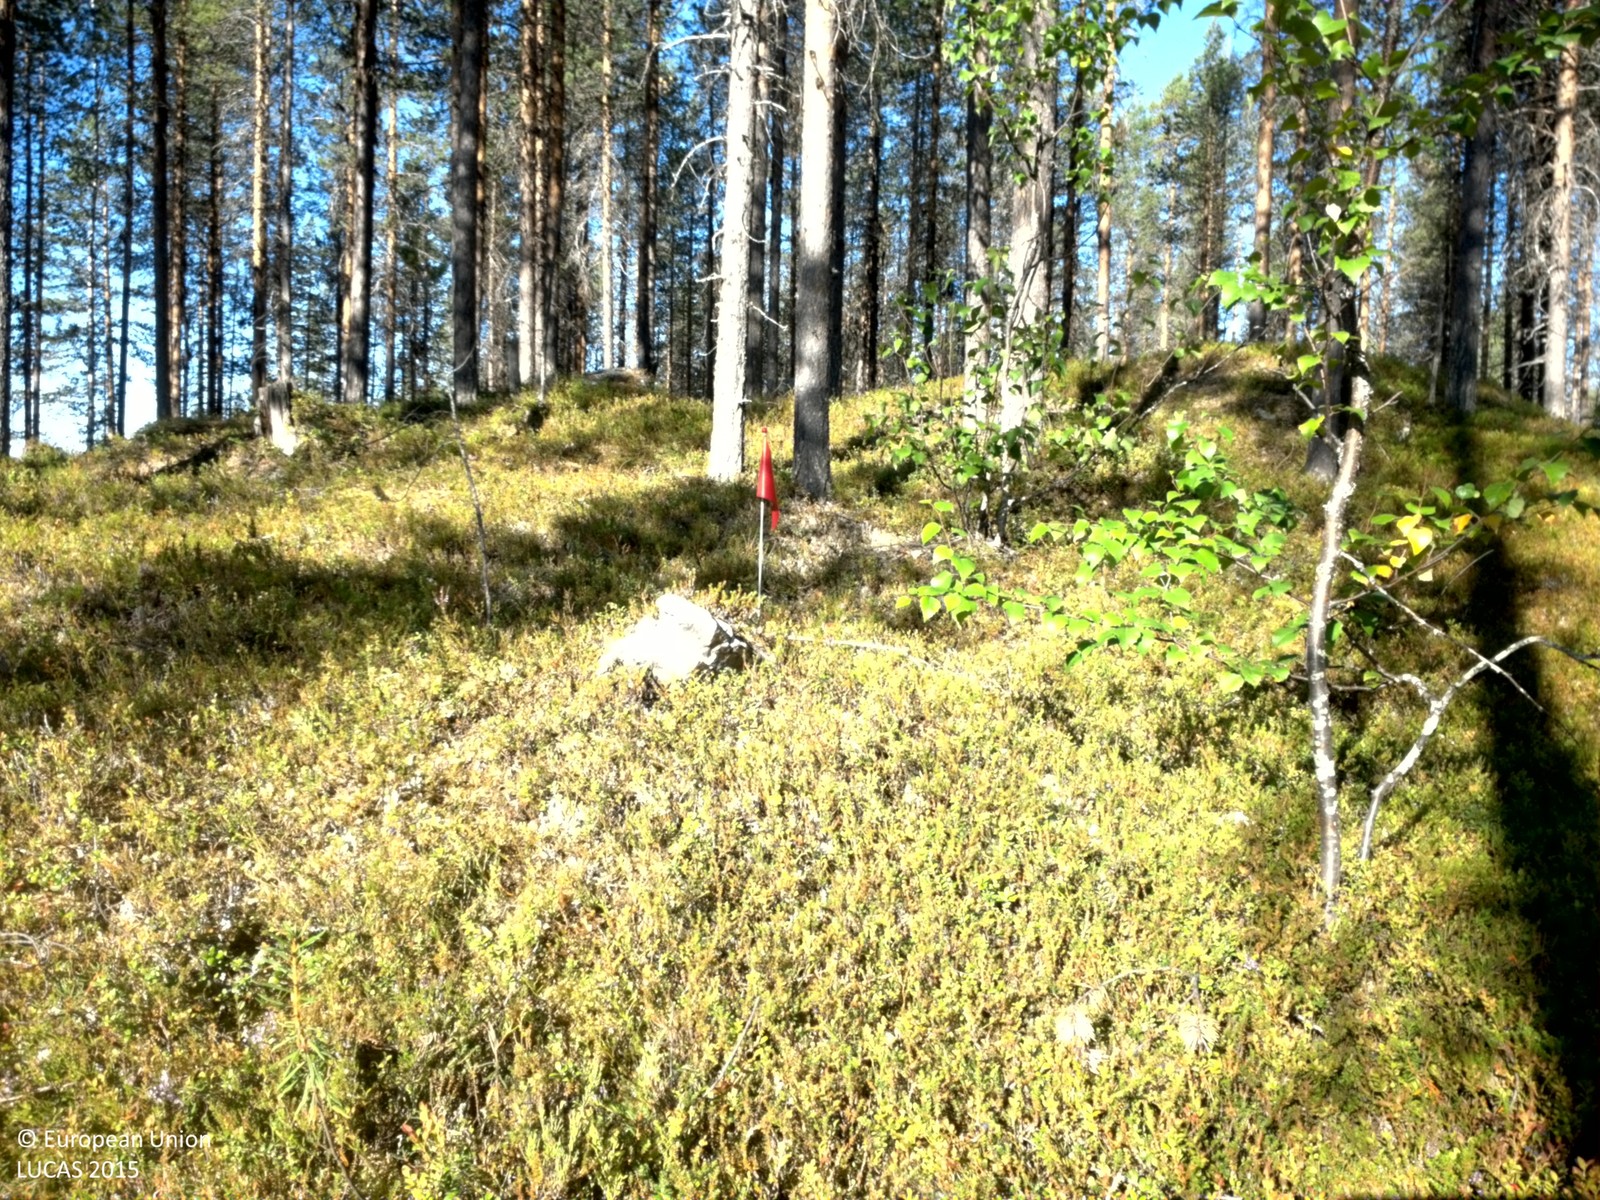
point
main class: Woodland
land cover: Pine dominated coniferous woodland
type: boreal forest
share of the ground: 25 - 50 %
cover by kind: shrubs 60 %, coniferous forest trees 35 %, consolidated bare surface 5 %
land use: Forestry
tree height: > 5 m
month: August
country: SE
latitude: 66.6799
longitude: 19.5716
